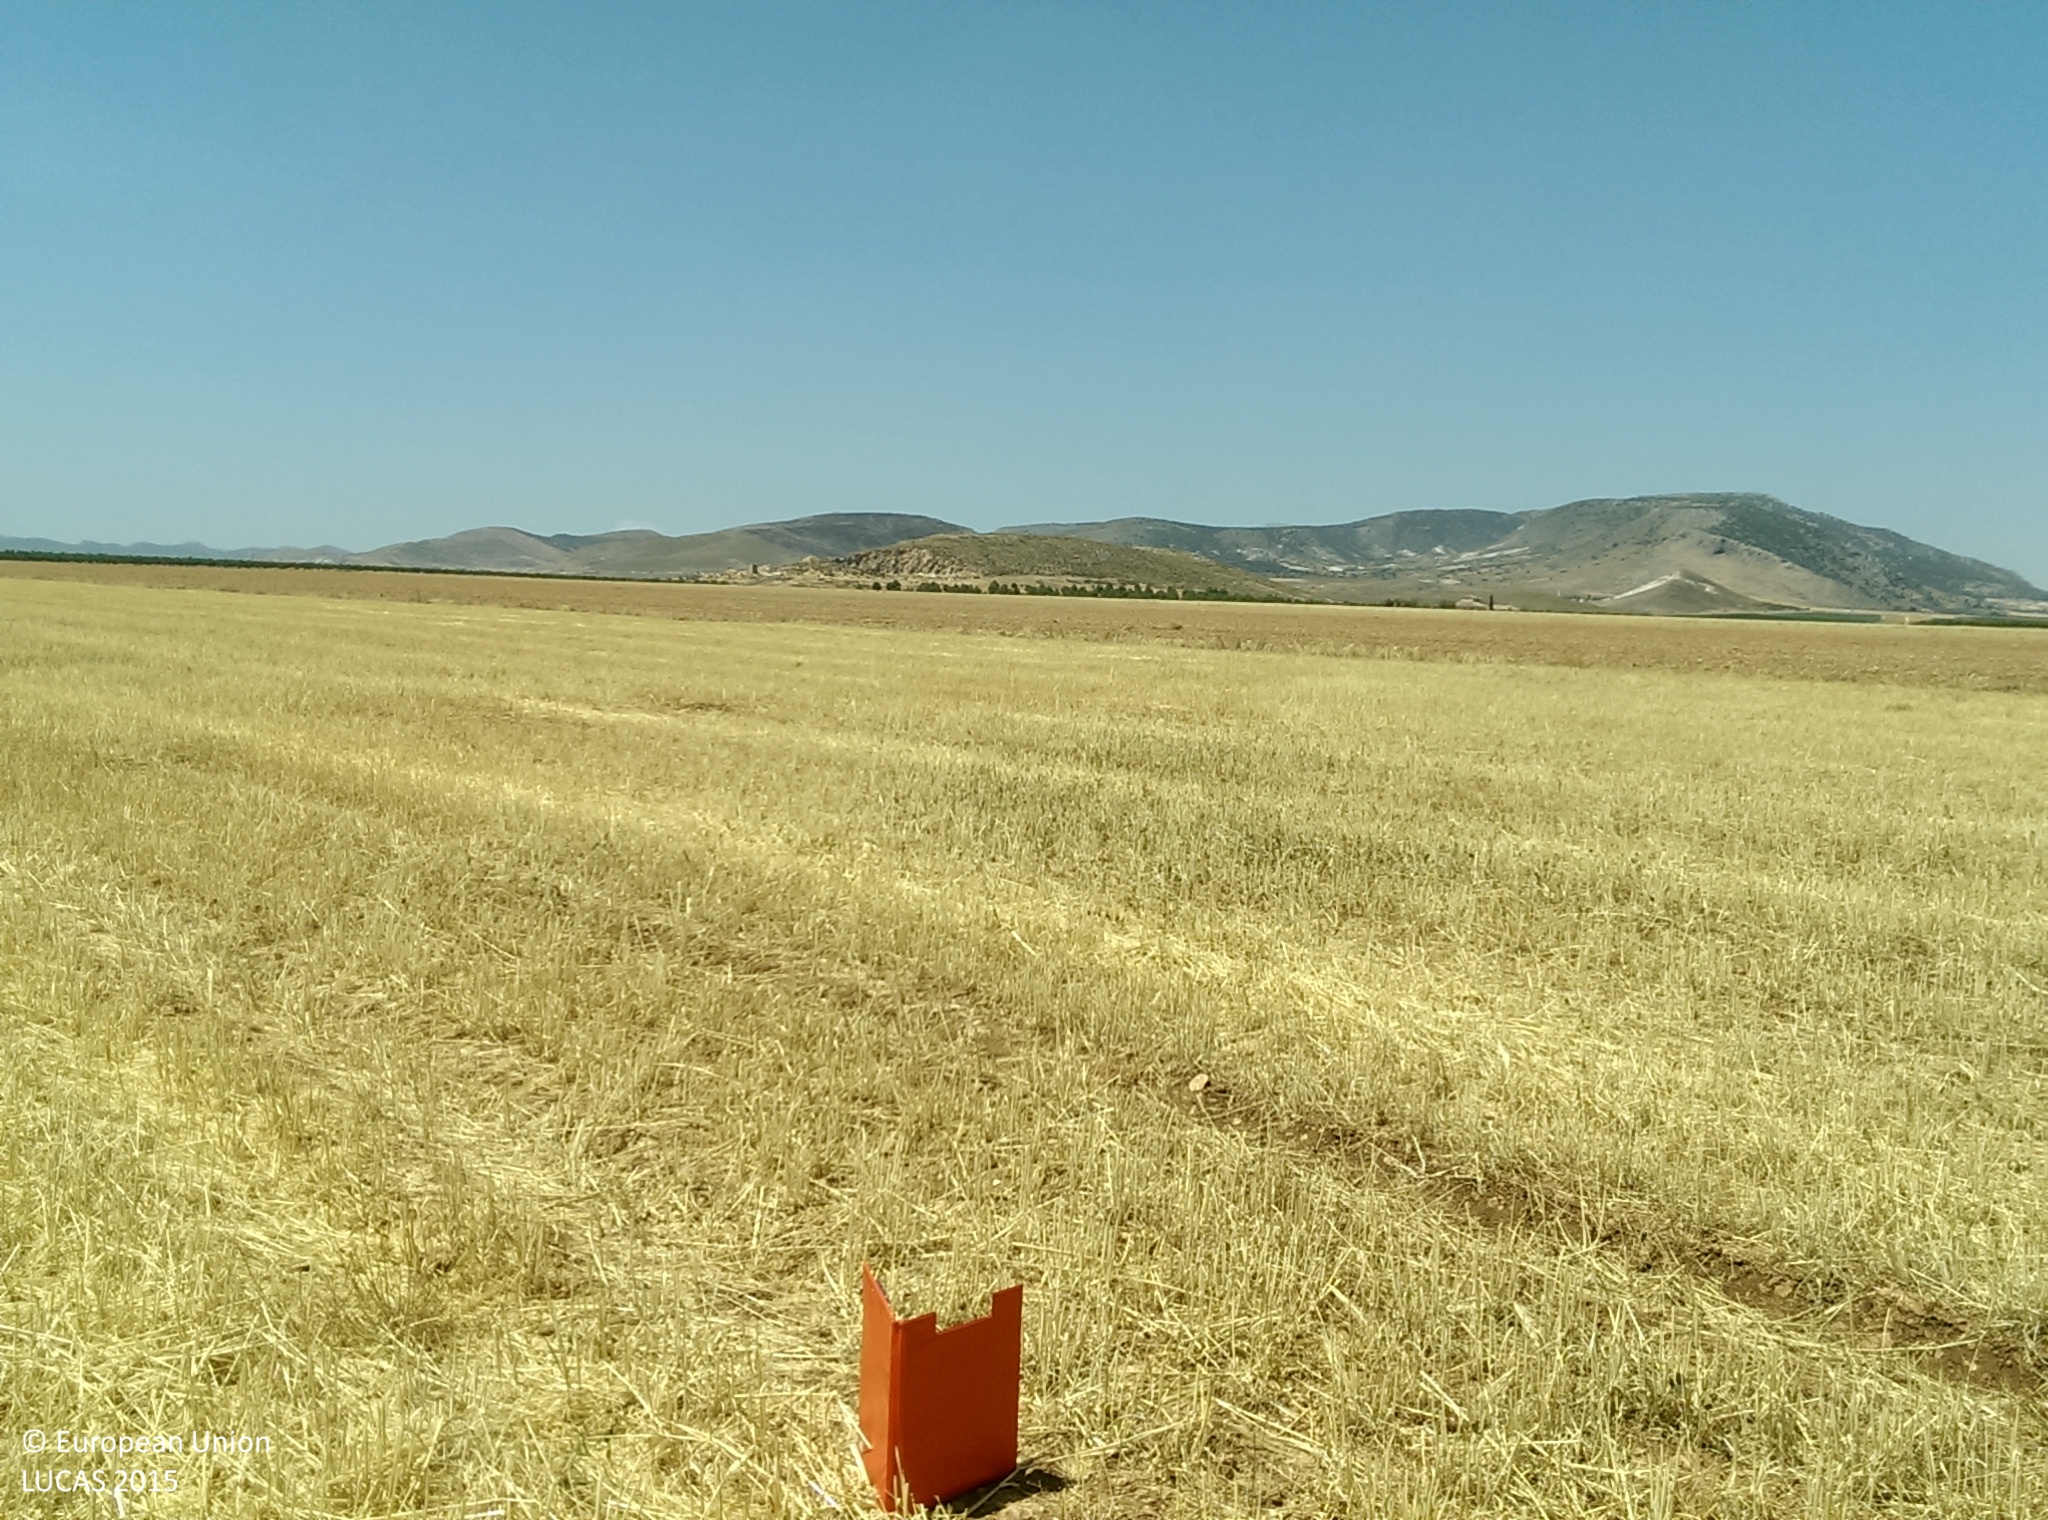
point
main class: Cropland
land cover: Barley
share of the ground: < 10 %
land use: Agriculture (excluding fallow land and kitchen gardens)
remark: Harvested field
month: July
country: ES
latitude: 37.4044
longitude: -3.2411
